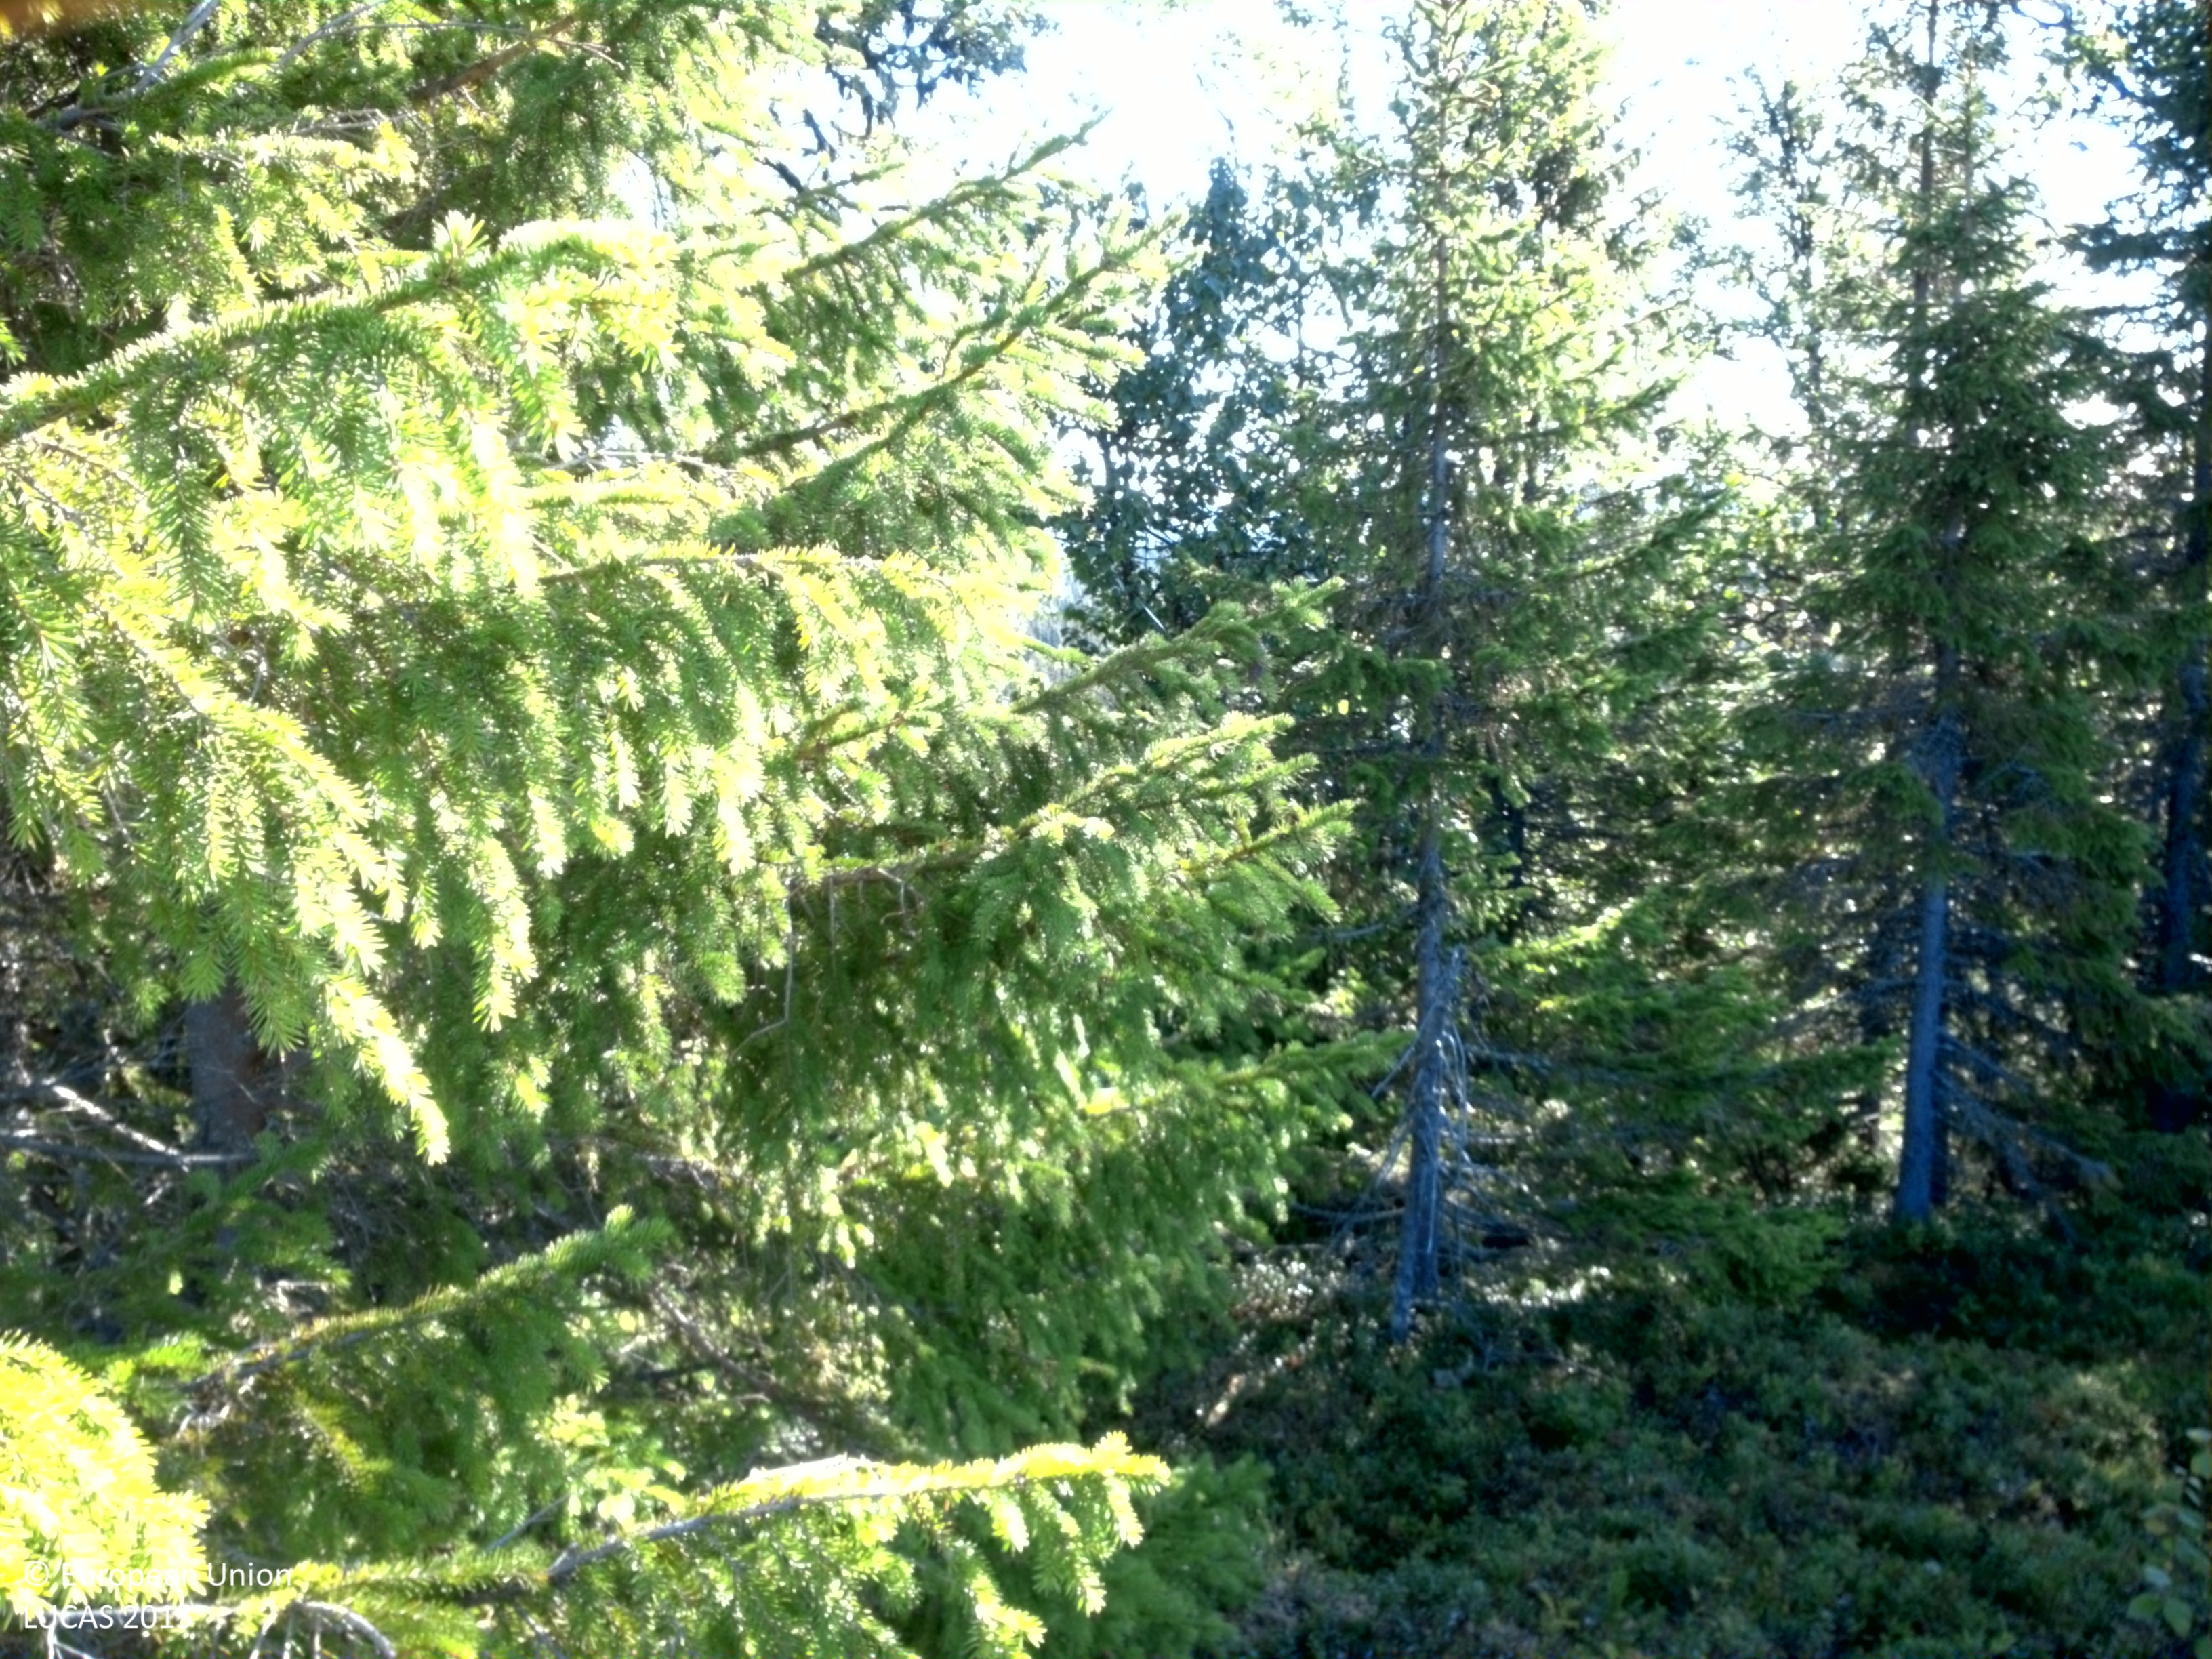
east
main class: Shrubland
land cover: Shrubland with sparse tree cover
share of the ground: 10 - 25 %
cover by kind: herbaceous plants 65 %, shrubs 20 %, broadleaved forest trees 5 %, lichens and mosses 5 %, unconsolidated bare surface 5 %
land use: Forestry
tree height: < 5 m
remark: Clear cut
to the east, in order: Shrubland with sparse tree cover; Spruce dominated mixed woodland; Spruce dominated coniferous woodland; Spruce dominated mixed woodland
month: September
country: SE
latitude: 65.2216
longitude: 16.1441
